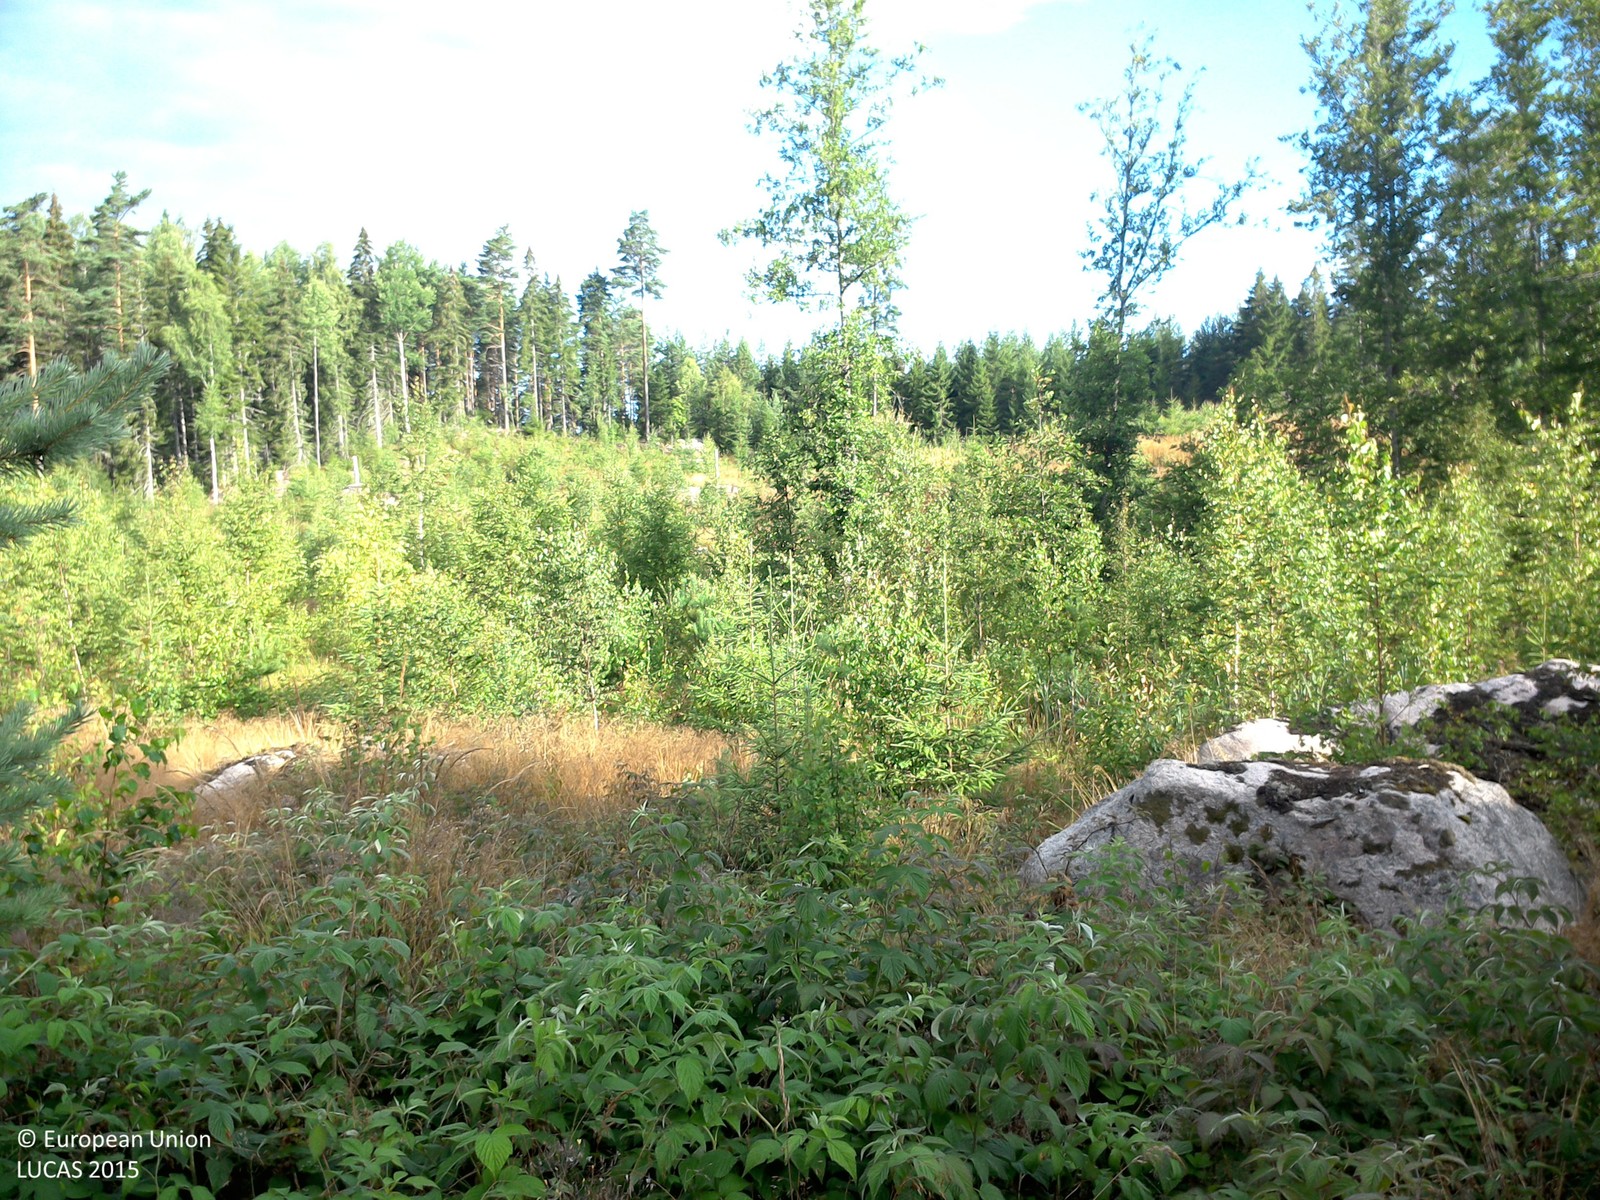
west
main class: Shrubland
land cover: Shrubland with sparse tree cover
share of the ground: > 75 %
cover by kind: shrubs 80 %, herbaceous plants 15 %, coniferous forest trees 5 %
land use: Forestry
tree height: < 5 m
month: August
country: SE
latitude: 58.1252
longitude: 15.0373
